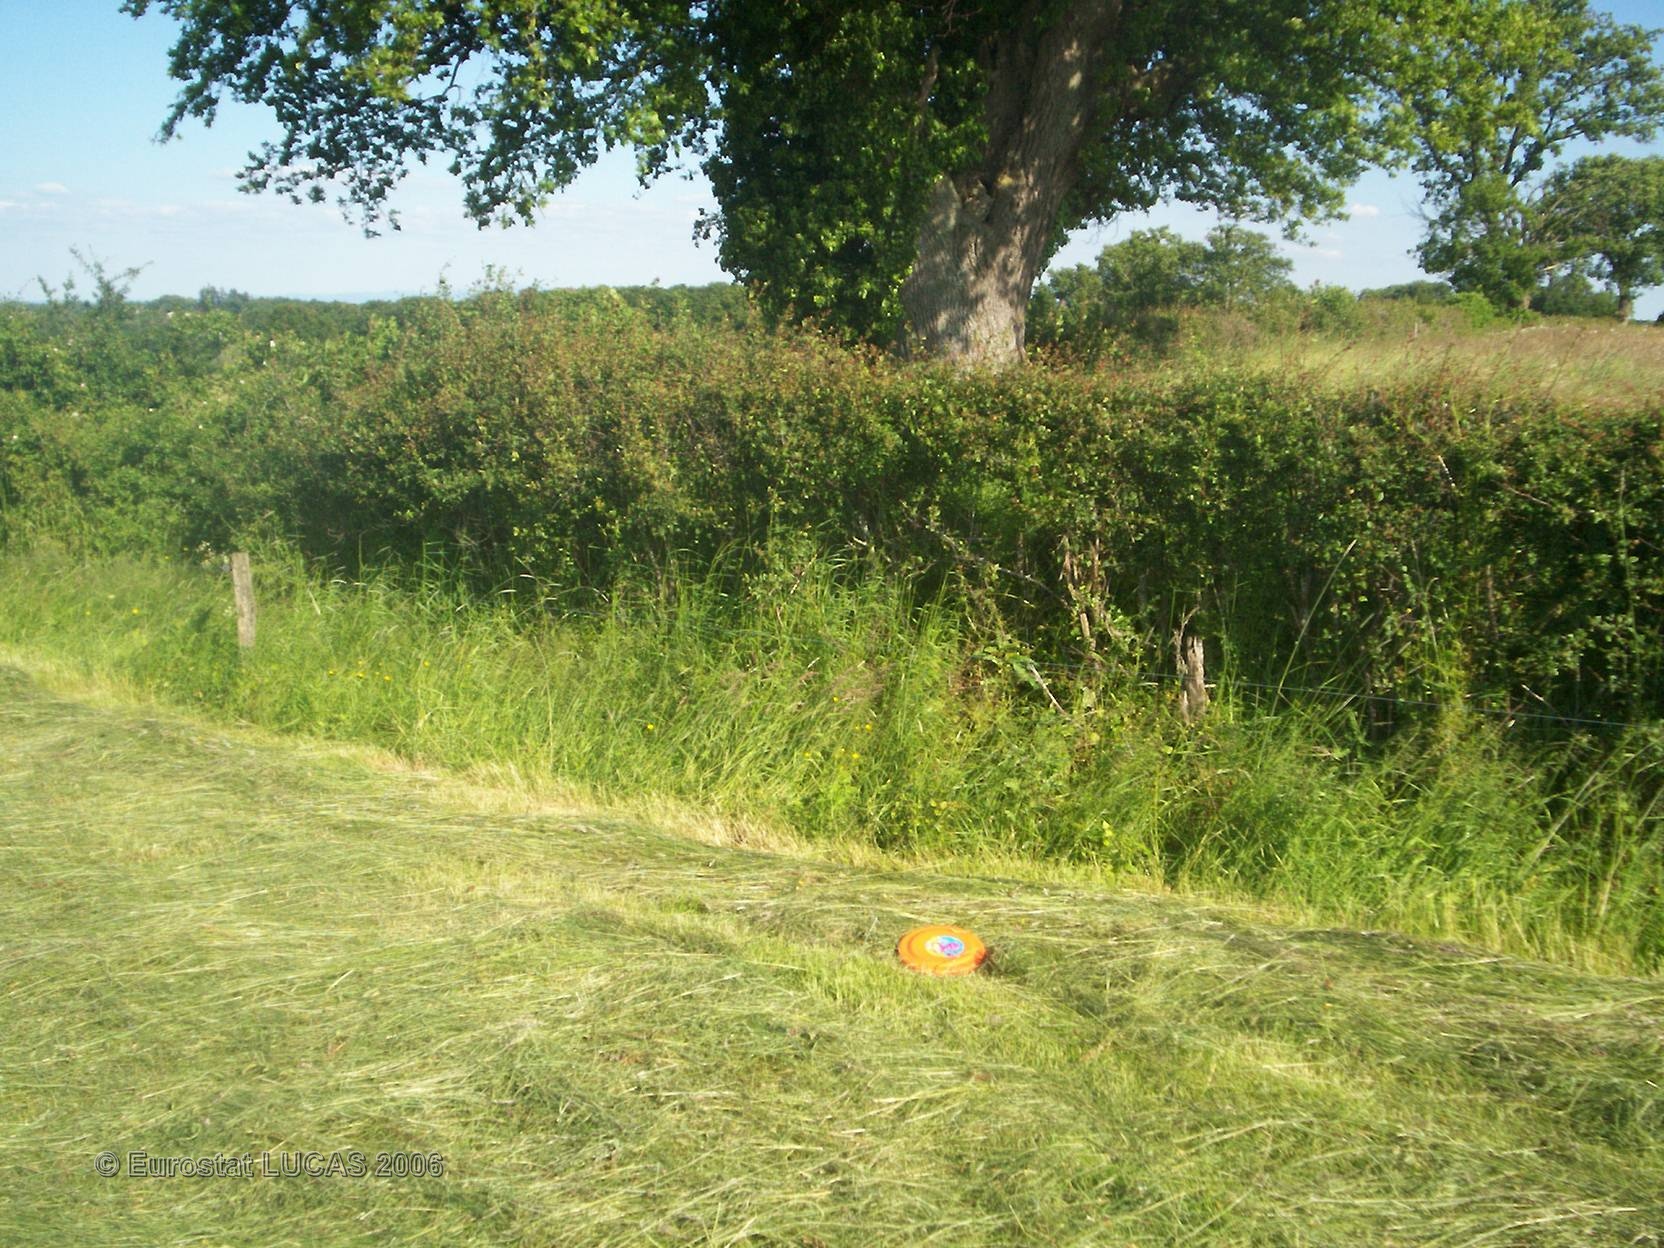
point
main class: Grassland
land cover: Grassland without tree/shrub cover
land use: Agriculture (excluding fallow land and kitchen gardens)
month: June
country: FR
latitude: 46.3126
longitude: 3.1548
